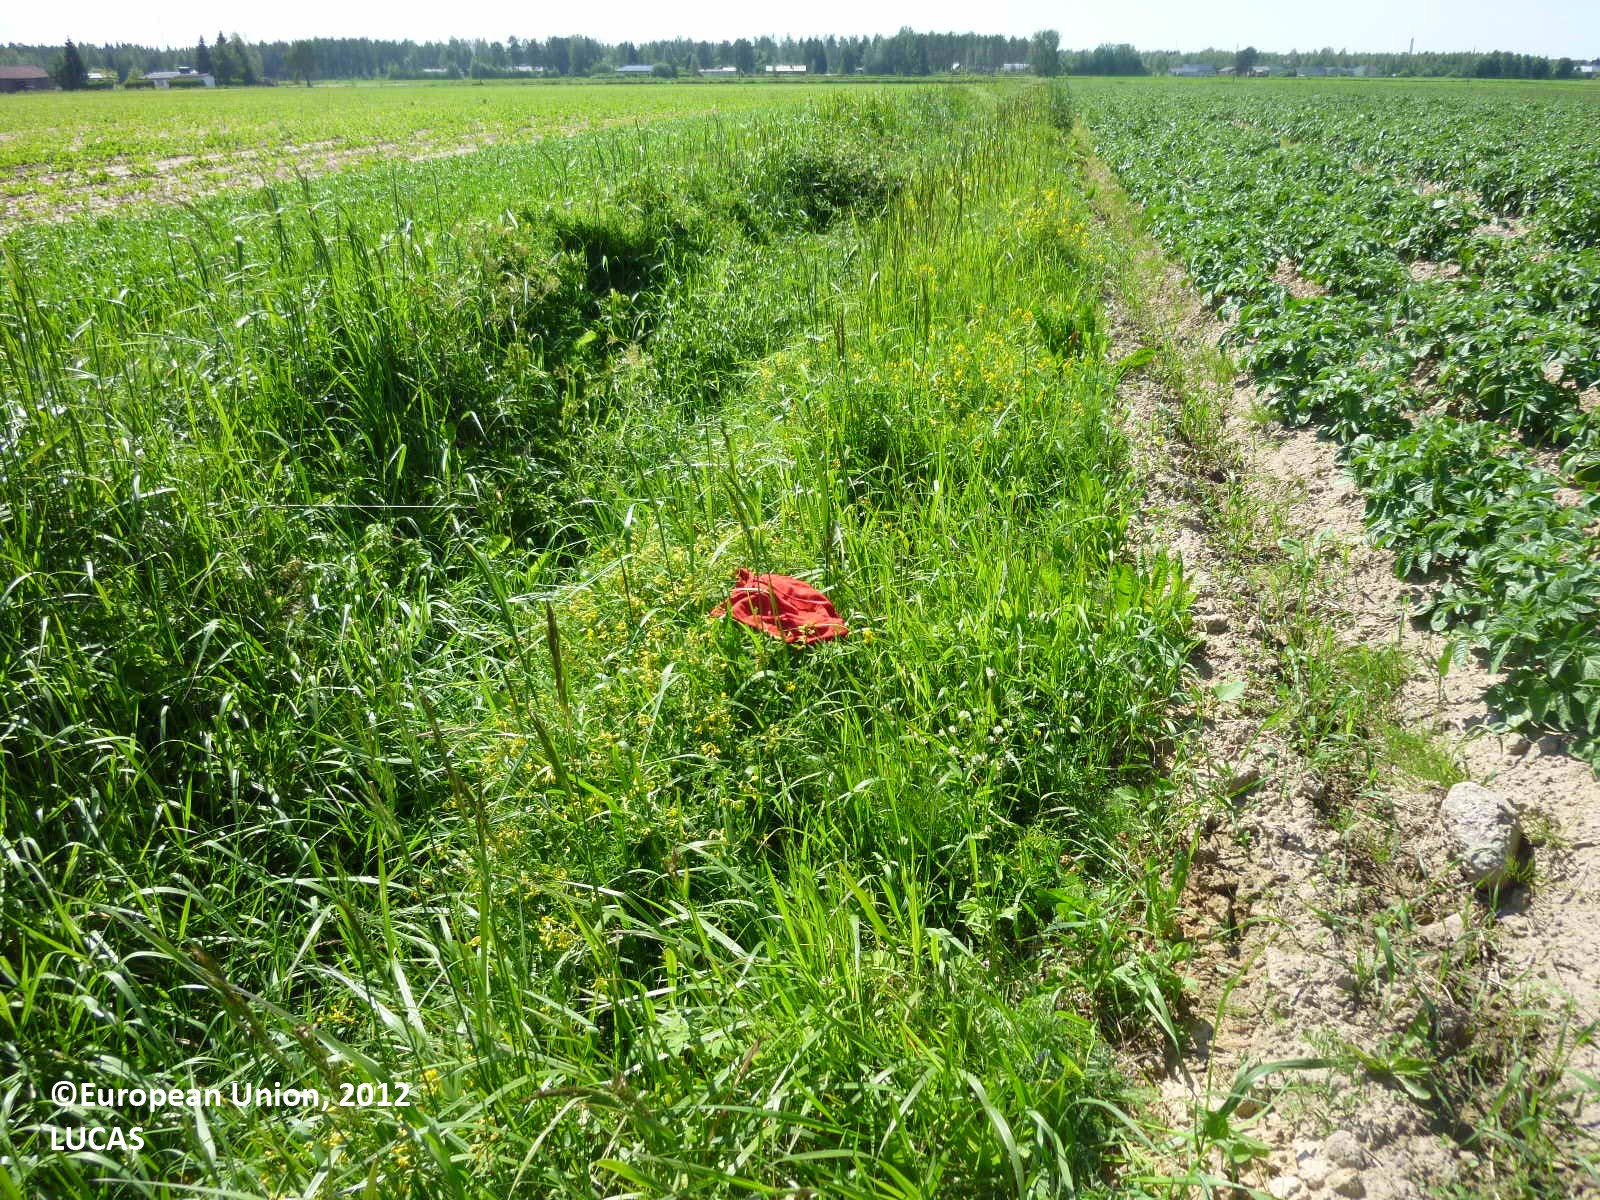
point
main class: Cropland
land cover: Potatoes
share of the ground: 25 - 50 %
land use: Agriculture (excluding fallow land and kitchen gardens)
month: July
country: FI
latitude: 61.3772
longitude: 22.0532
